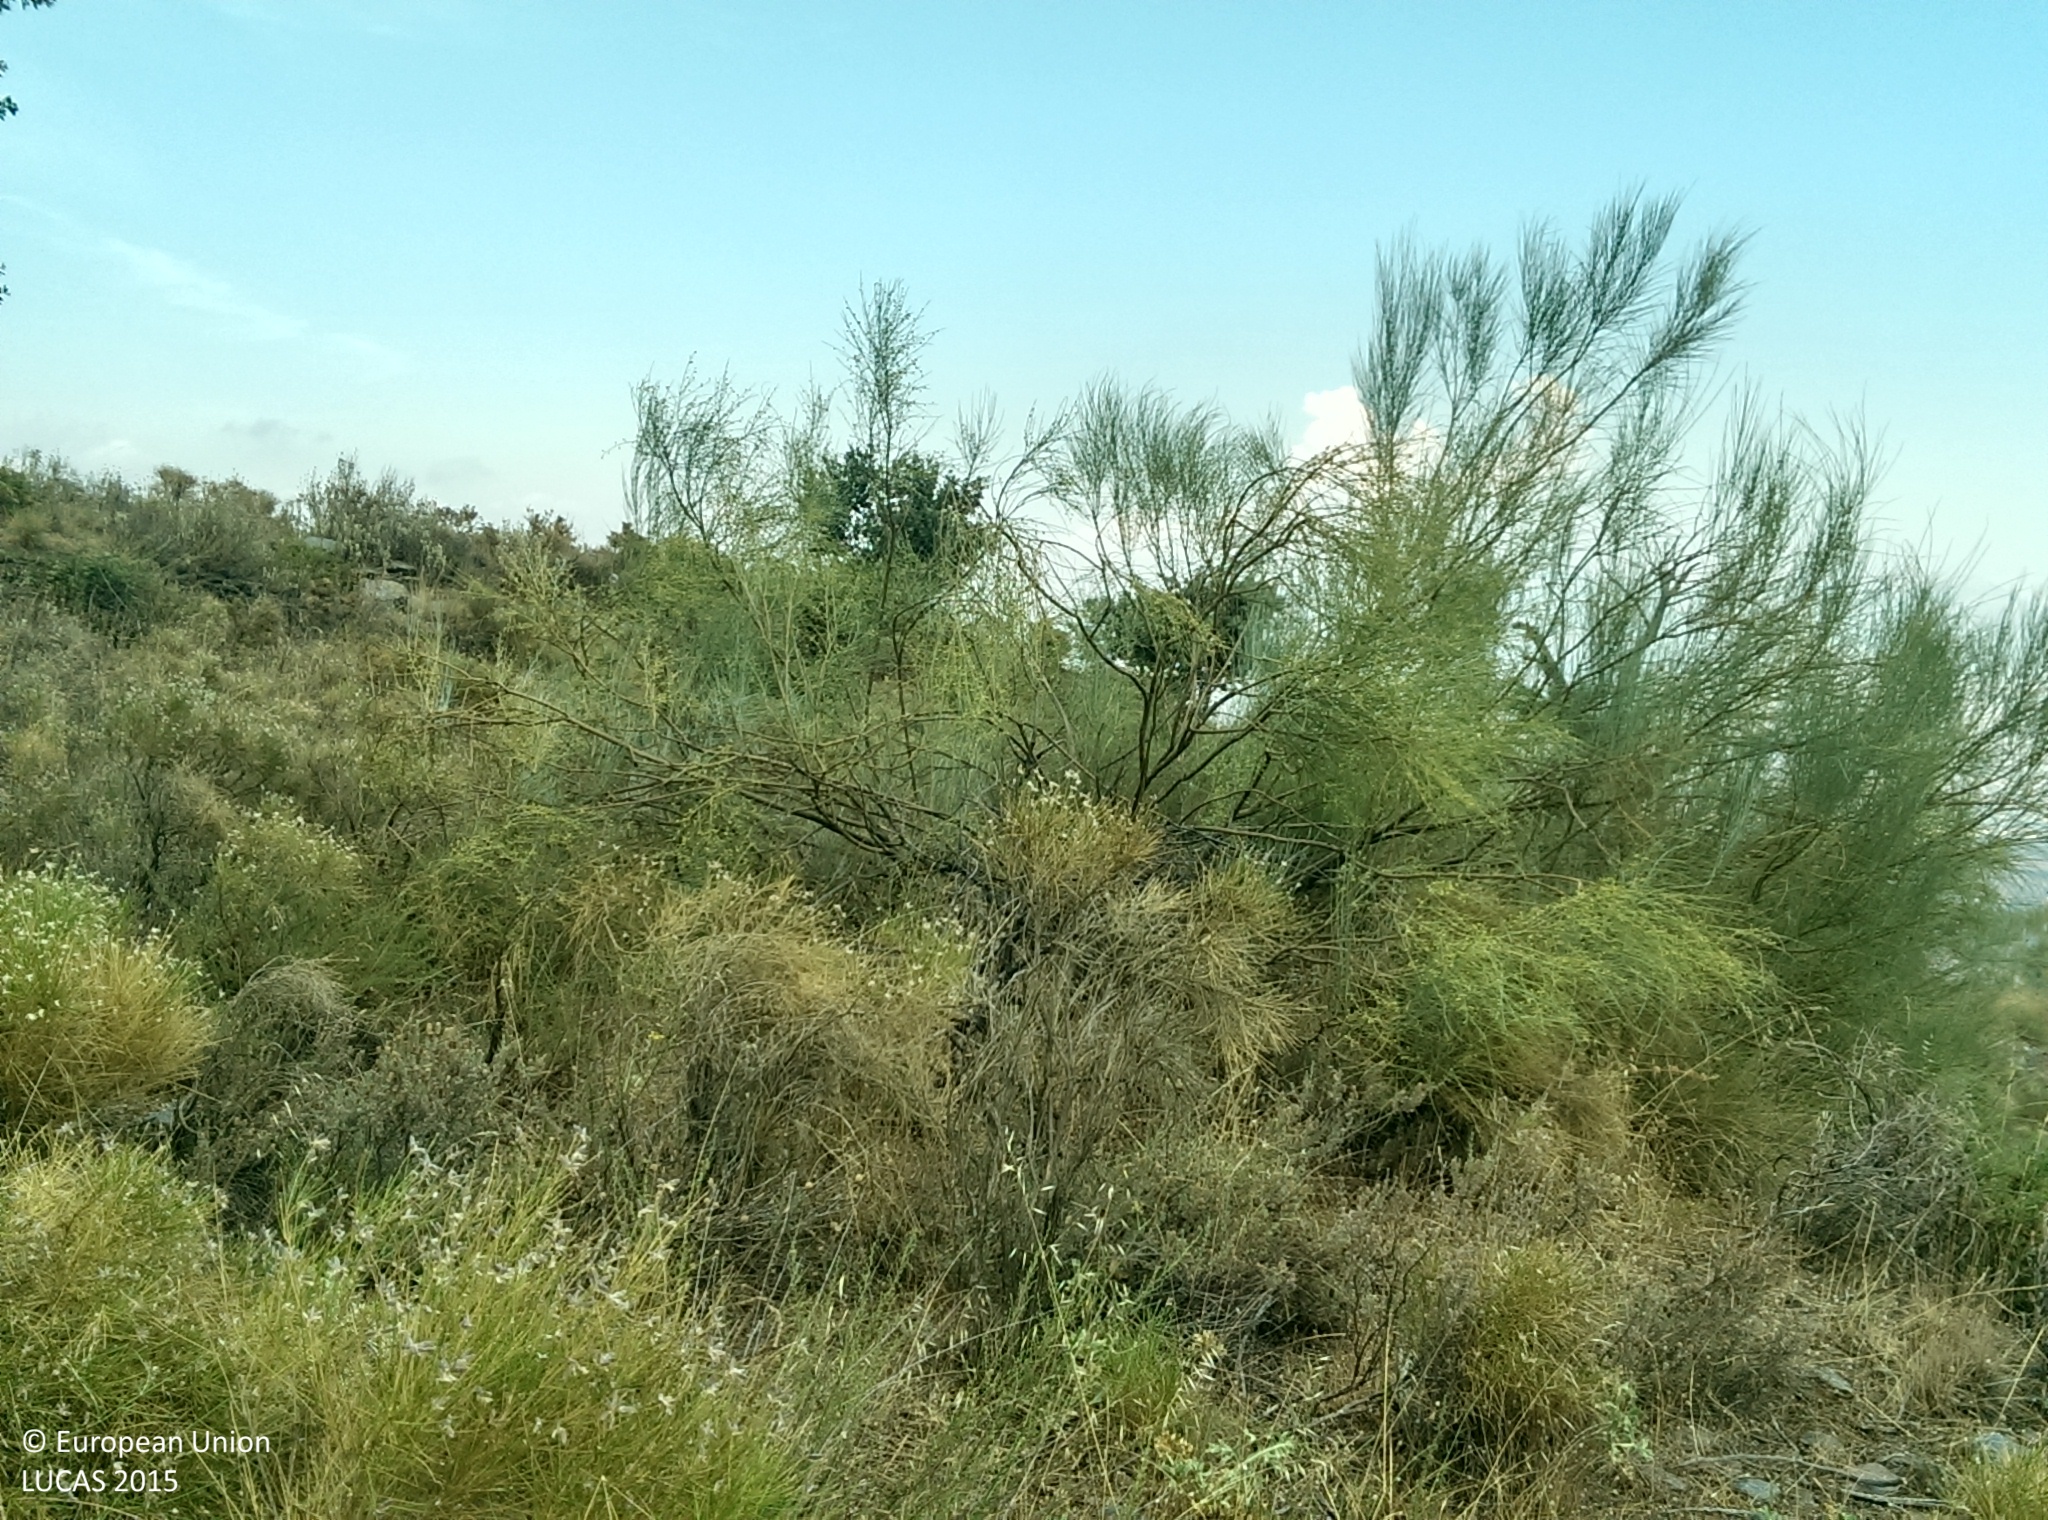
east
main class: Shrubland
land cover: Shrubland with sparse tree cover
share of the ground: > 75 %
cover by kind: shrubs 70 %, herbaceous plants 20 %, broadleaved forest trees 5 %, unconsolidated bare surface 5 %
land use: Semi-natural and natural areas not in use
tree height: < 5 m
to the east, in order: Shrubland with sparse tree cover; Dry stone walls; Shrubland with sparse tree cover; Dry stone walls; Shrubland without tree cover; Tracks; Shrubland without tree cover; Tracks; Shrubland without tree cover
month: July
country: ES
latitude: 36.9997
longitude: -3.1182
